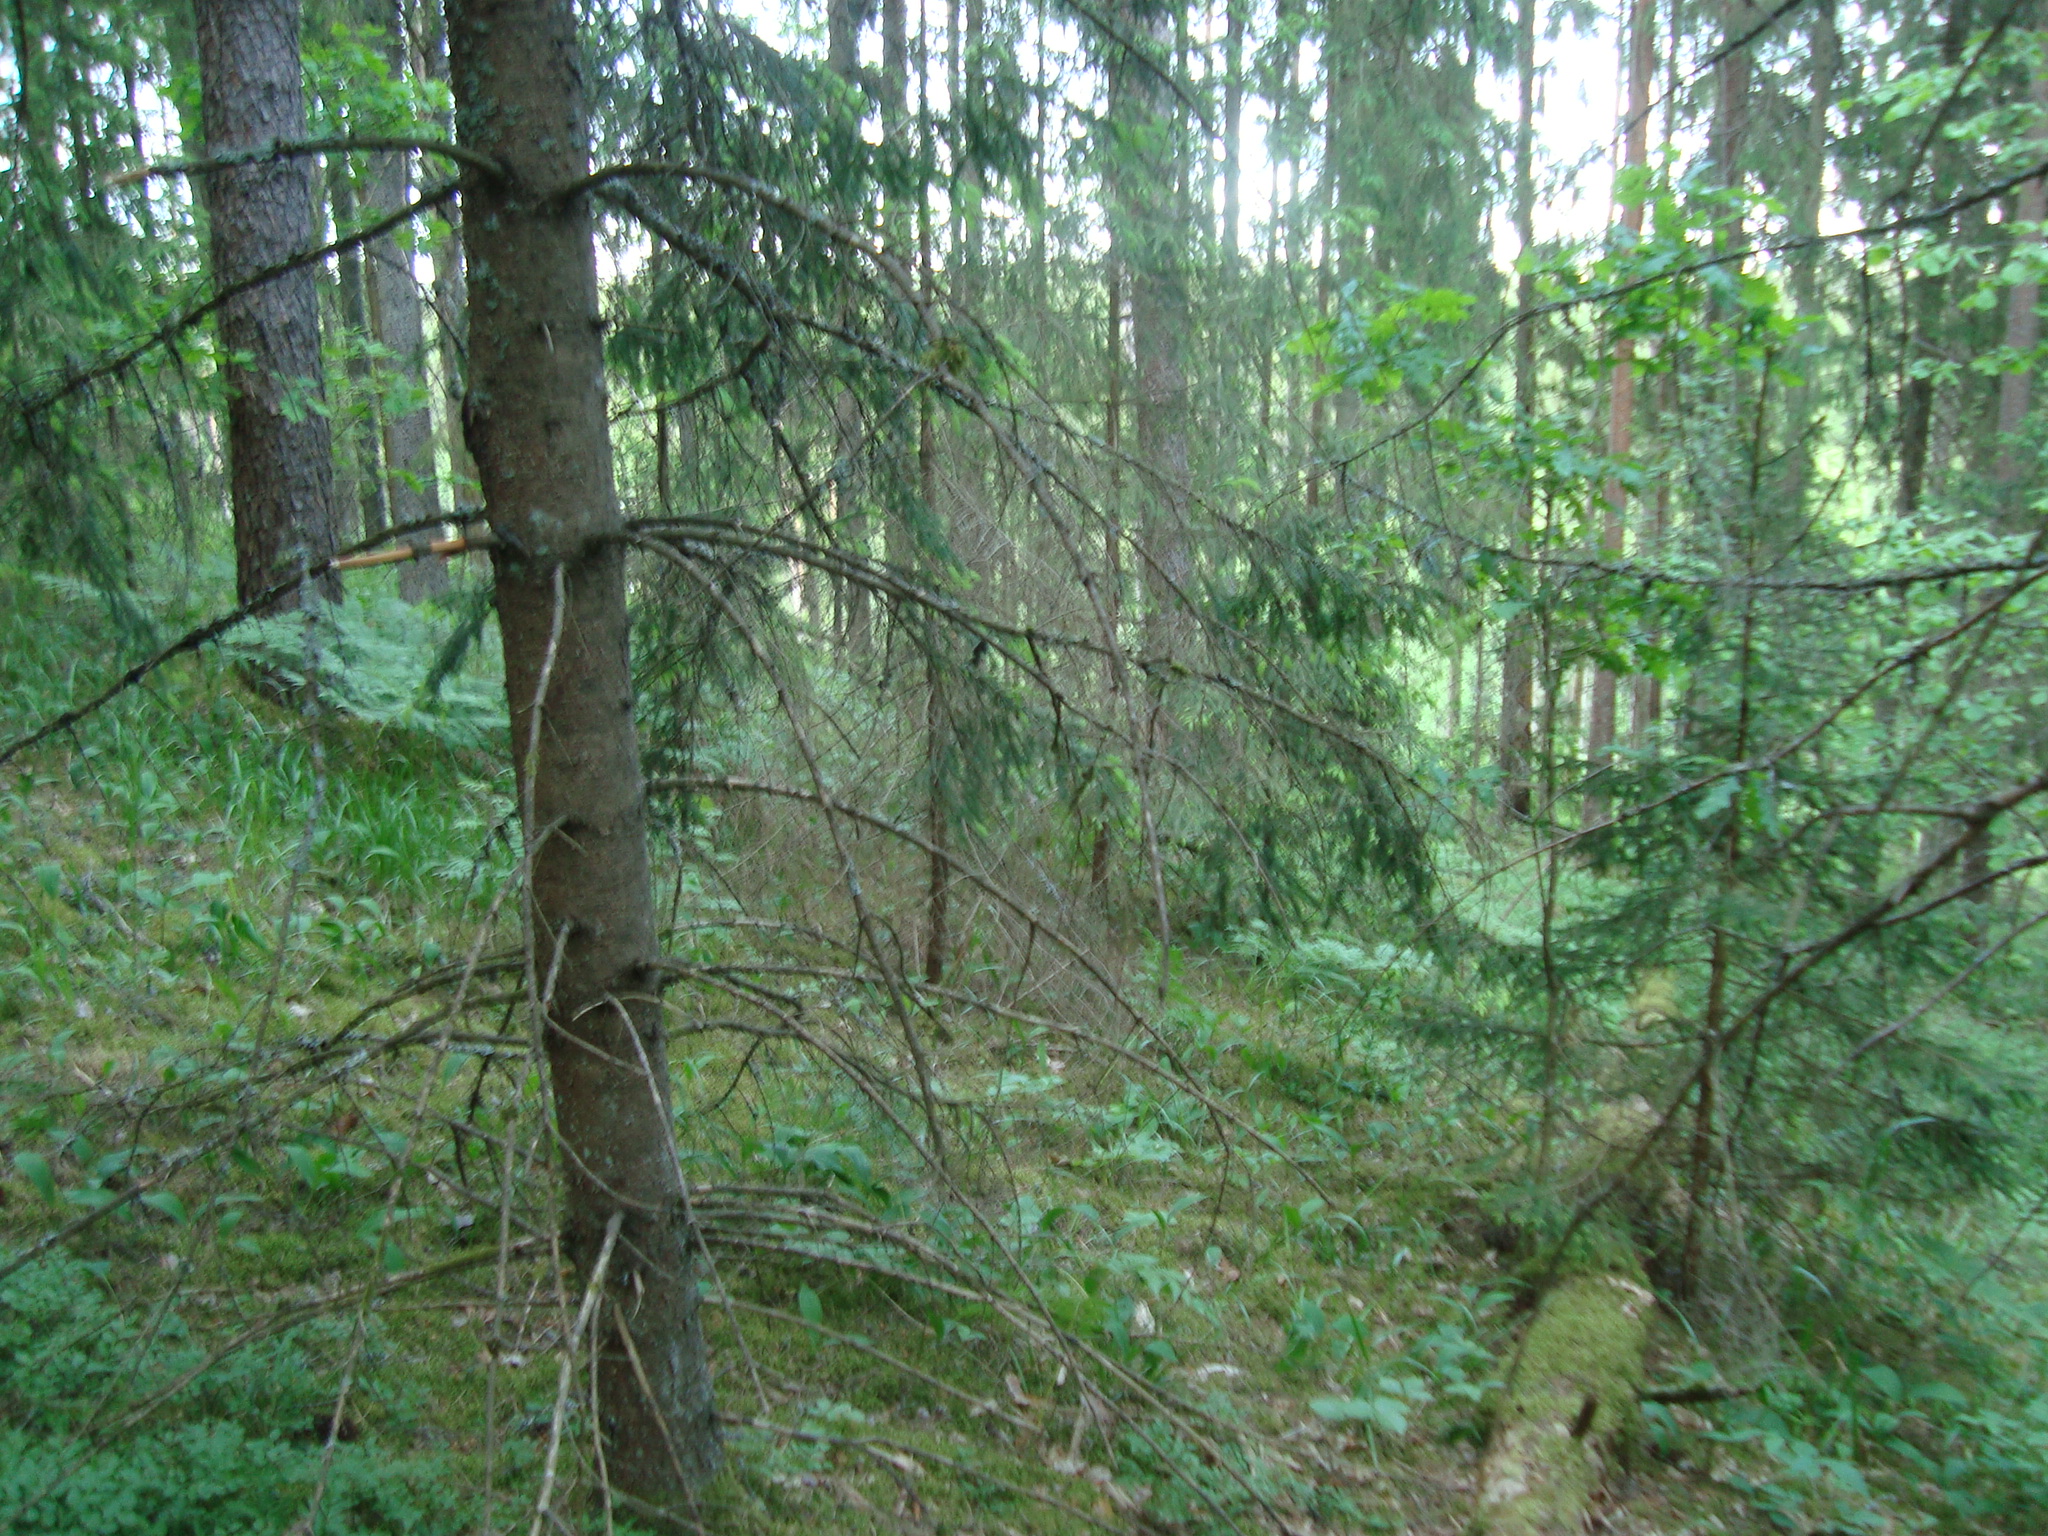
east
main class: Woodland
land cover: Spruce dominated coniferous woodland
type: hemiboreal forest and nemoral coniferous forest and mixed broadleaved-coniferous forest
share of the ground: > 75 %
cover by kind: coniferous forest trees 80 %, herbaceous plants 10 %, broadleaved forest trees 5 %, lichens and mosses 5 %
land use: Forestry
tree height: > 5 m
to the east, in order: Spruce dominated coniferous woodland; Spontaneously vegetated surfaces; Spruce dominated mixed woodland
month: June
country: LV
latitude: 56.6934
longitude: 25.7523
